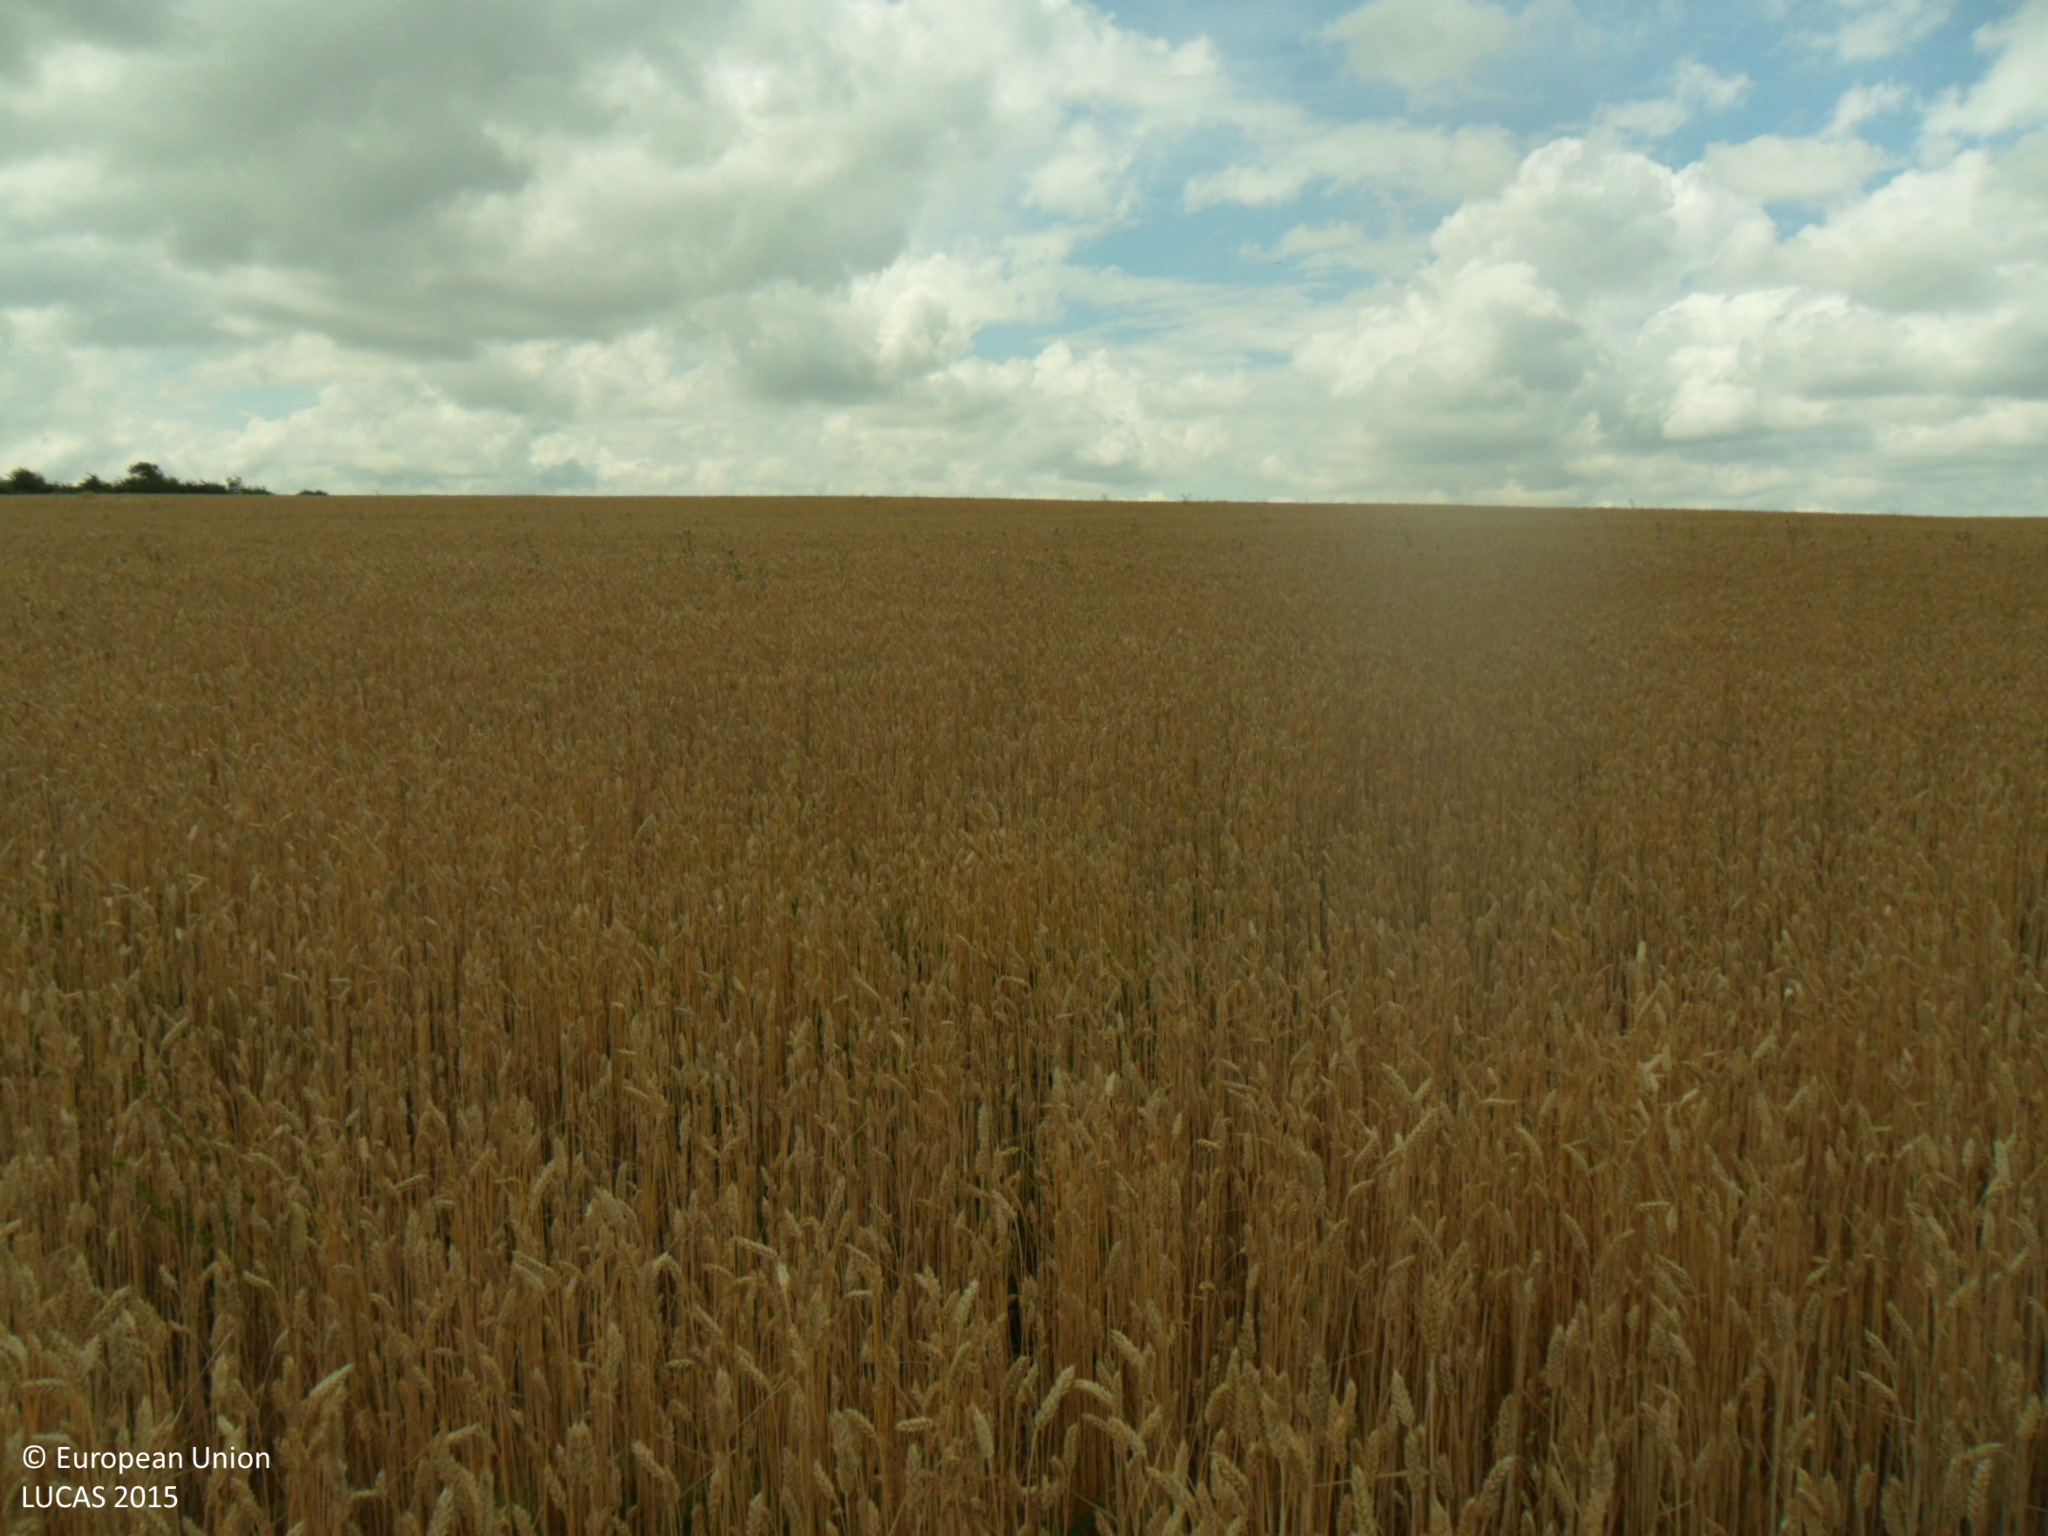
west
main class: Cropland
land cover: Common wheat
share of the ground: > 75 %
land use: Agriculture (excluding fallow land and kitchen gardens)
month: July
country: BG
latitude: 43.4430
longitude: 27.2613
